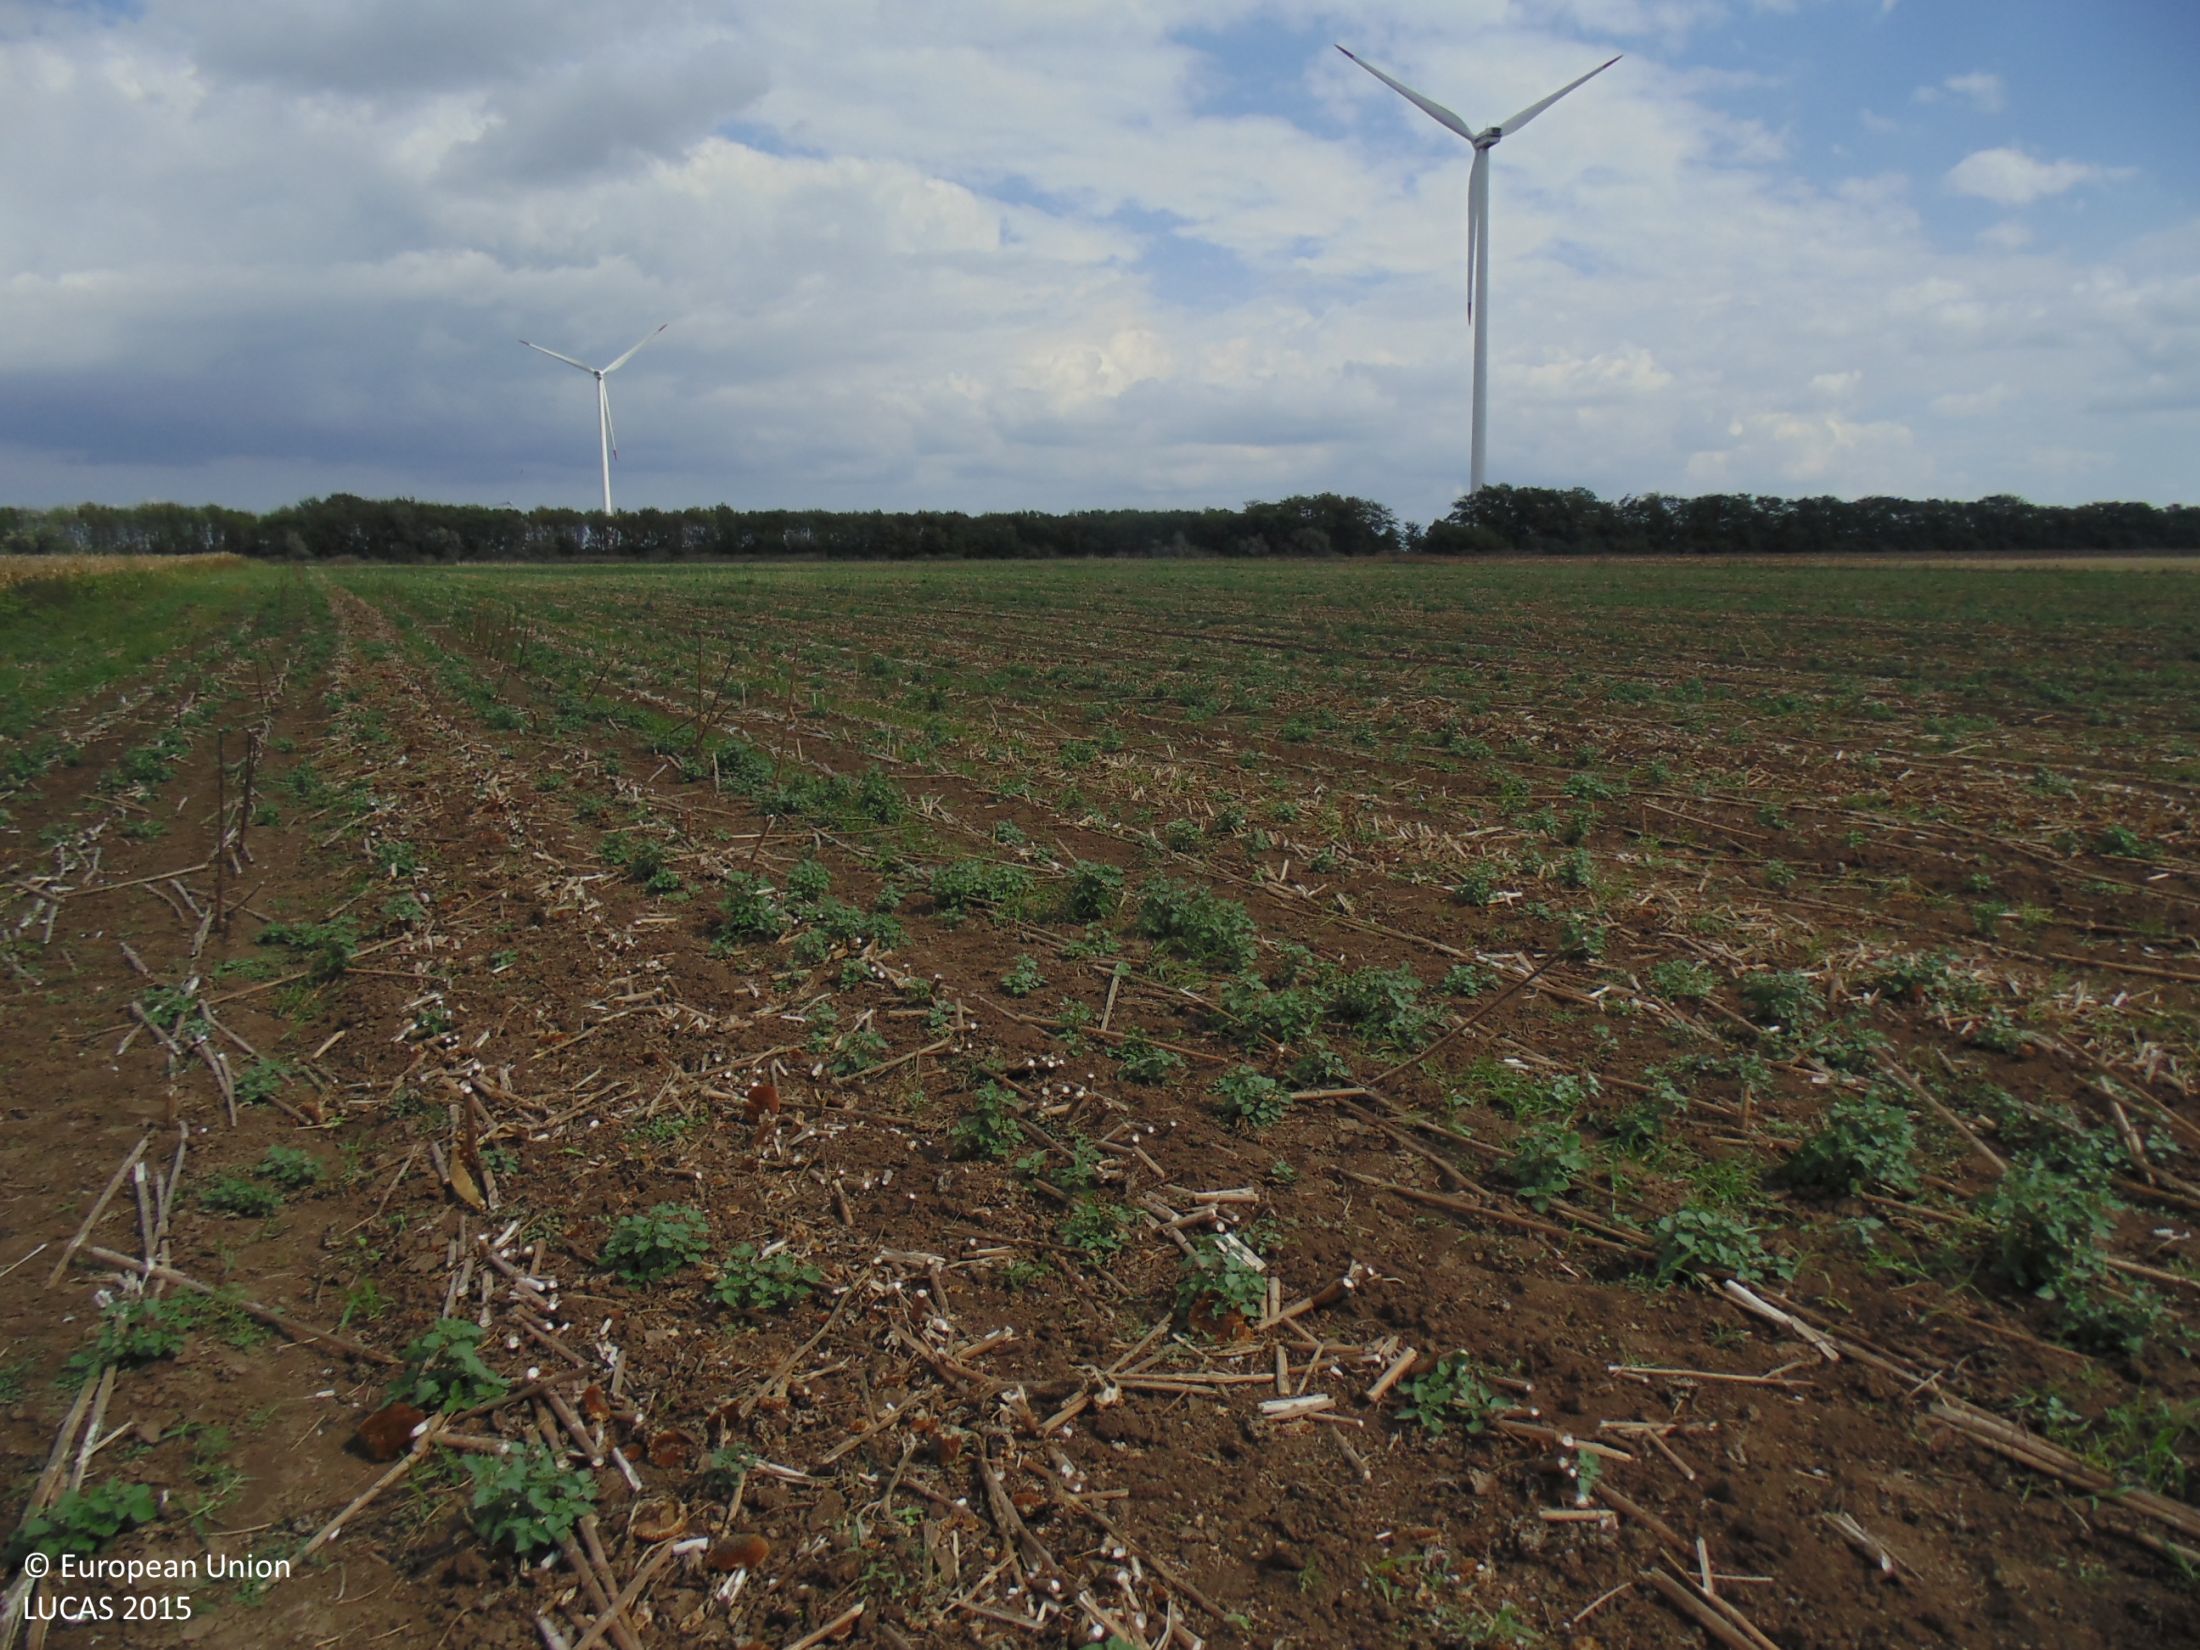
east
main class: Cropland
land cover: Sunflower
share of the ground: < 10 %
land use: Agriculture (excluding fallow land and kitchen gardens)
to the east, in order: Sunflower
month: September
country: BG
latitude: 43.4346
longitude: 28.4552
